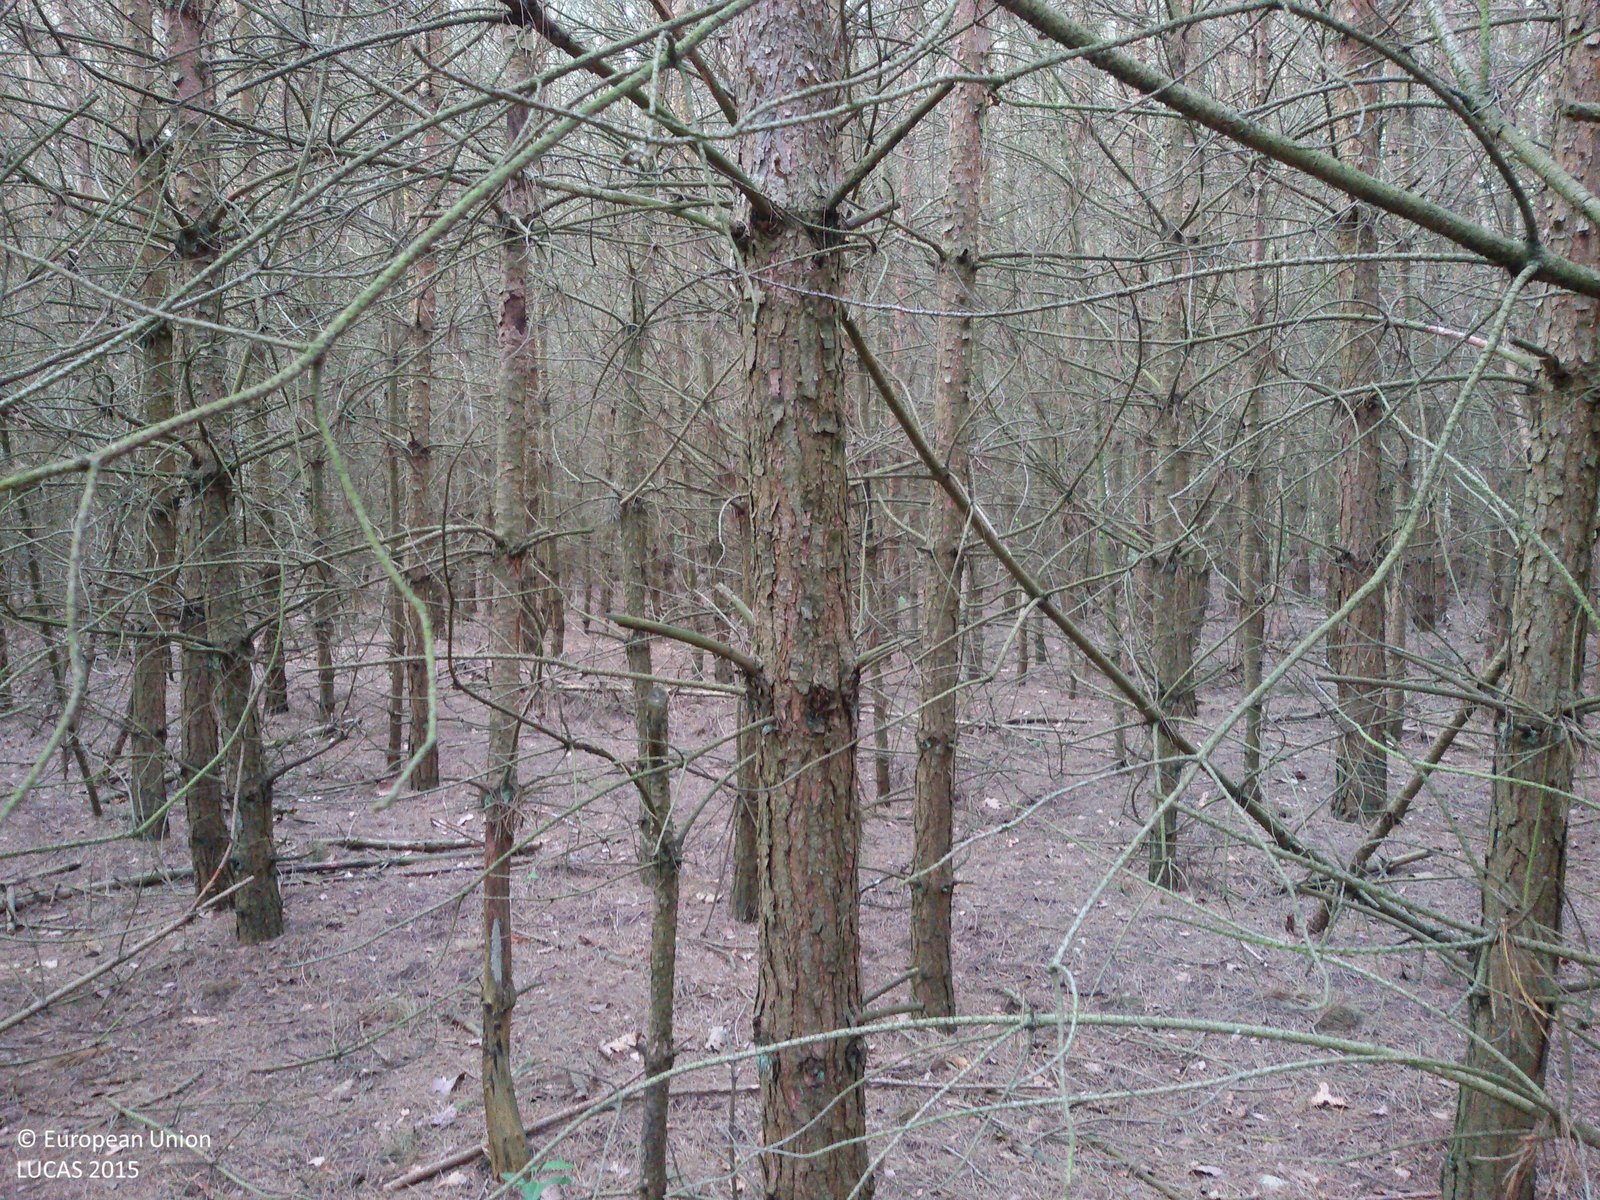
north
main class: Woodland
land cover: Pine dominated coniferous woodland
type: hemiboreal forest and nemoral coniferous forest and mixed broadleaved-coniferous forest
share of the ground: > 75 %
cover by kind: coniferous forest trees 100 %
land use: Forestry
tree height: > 5 m
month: May
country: PL
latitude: 53.1317
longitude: 17.2295
